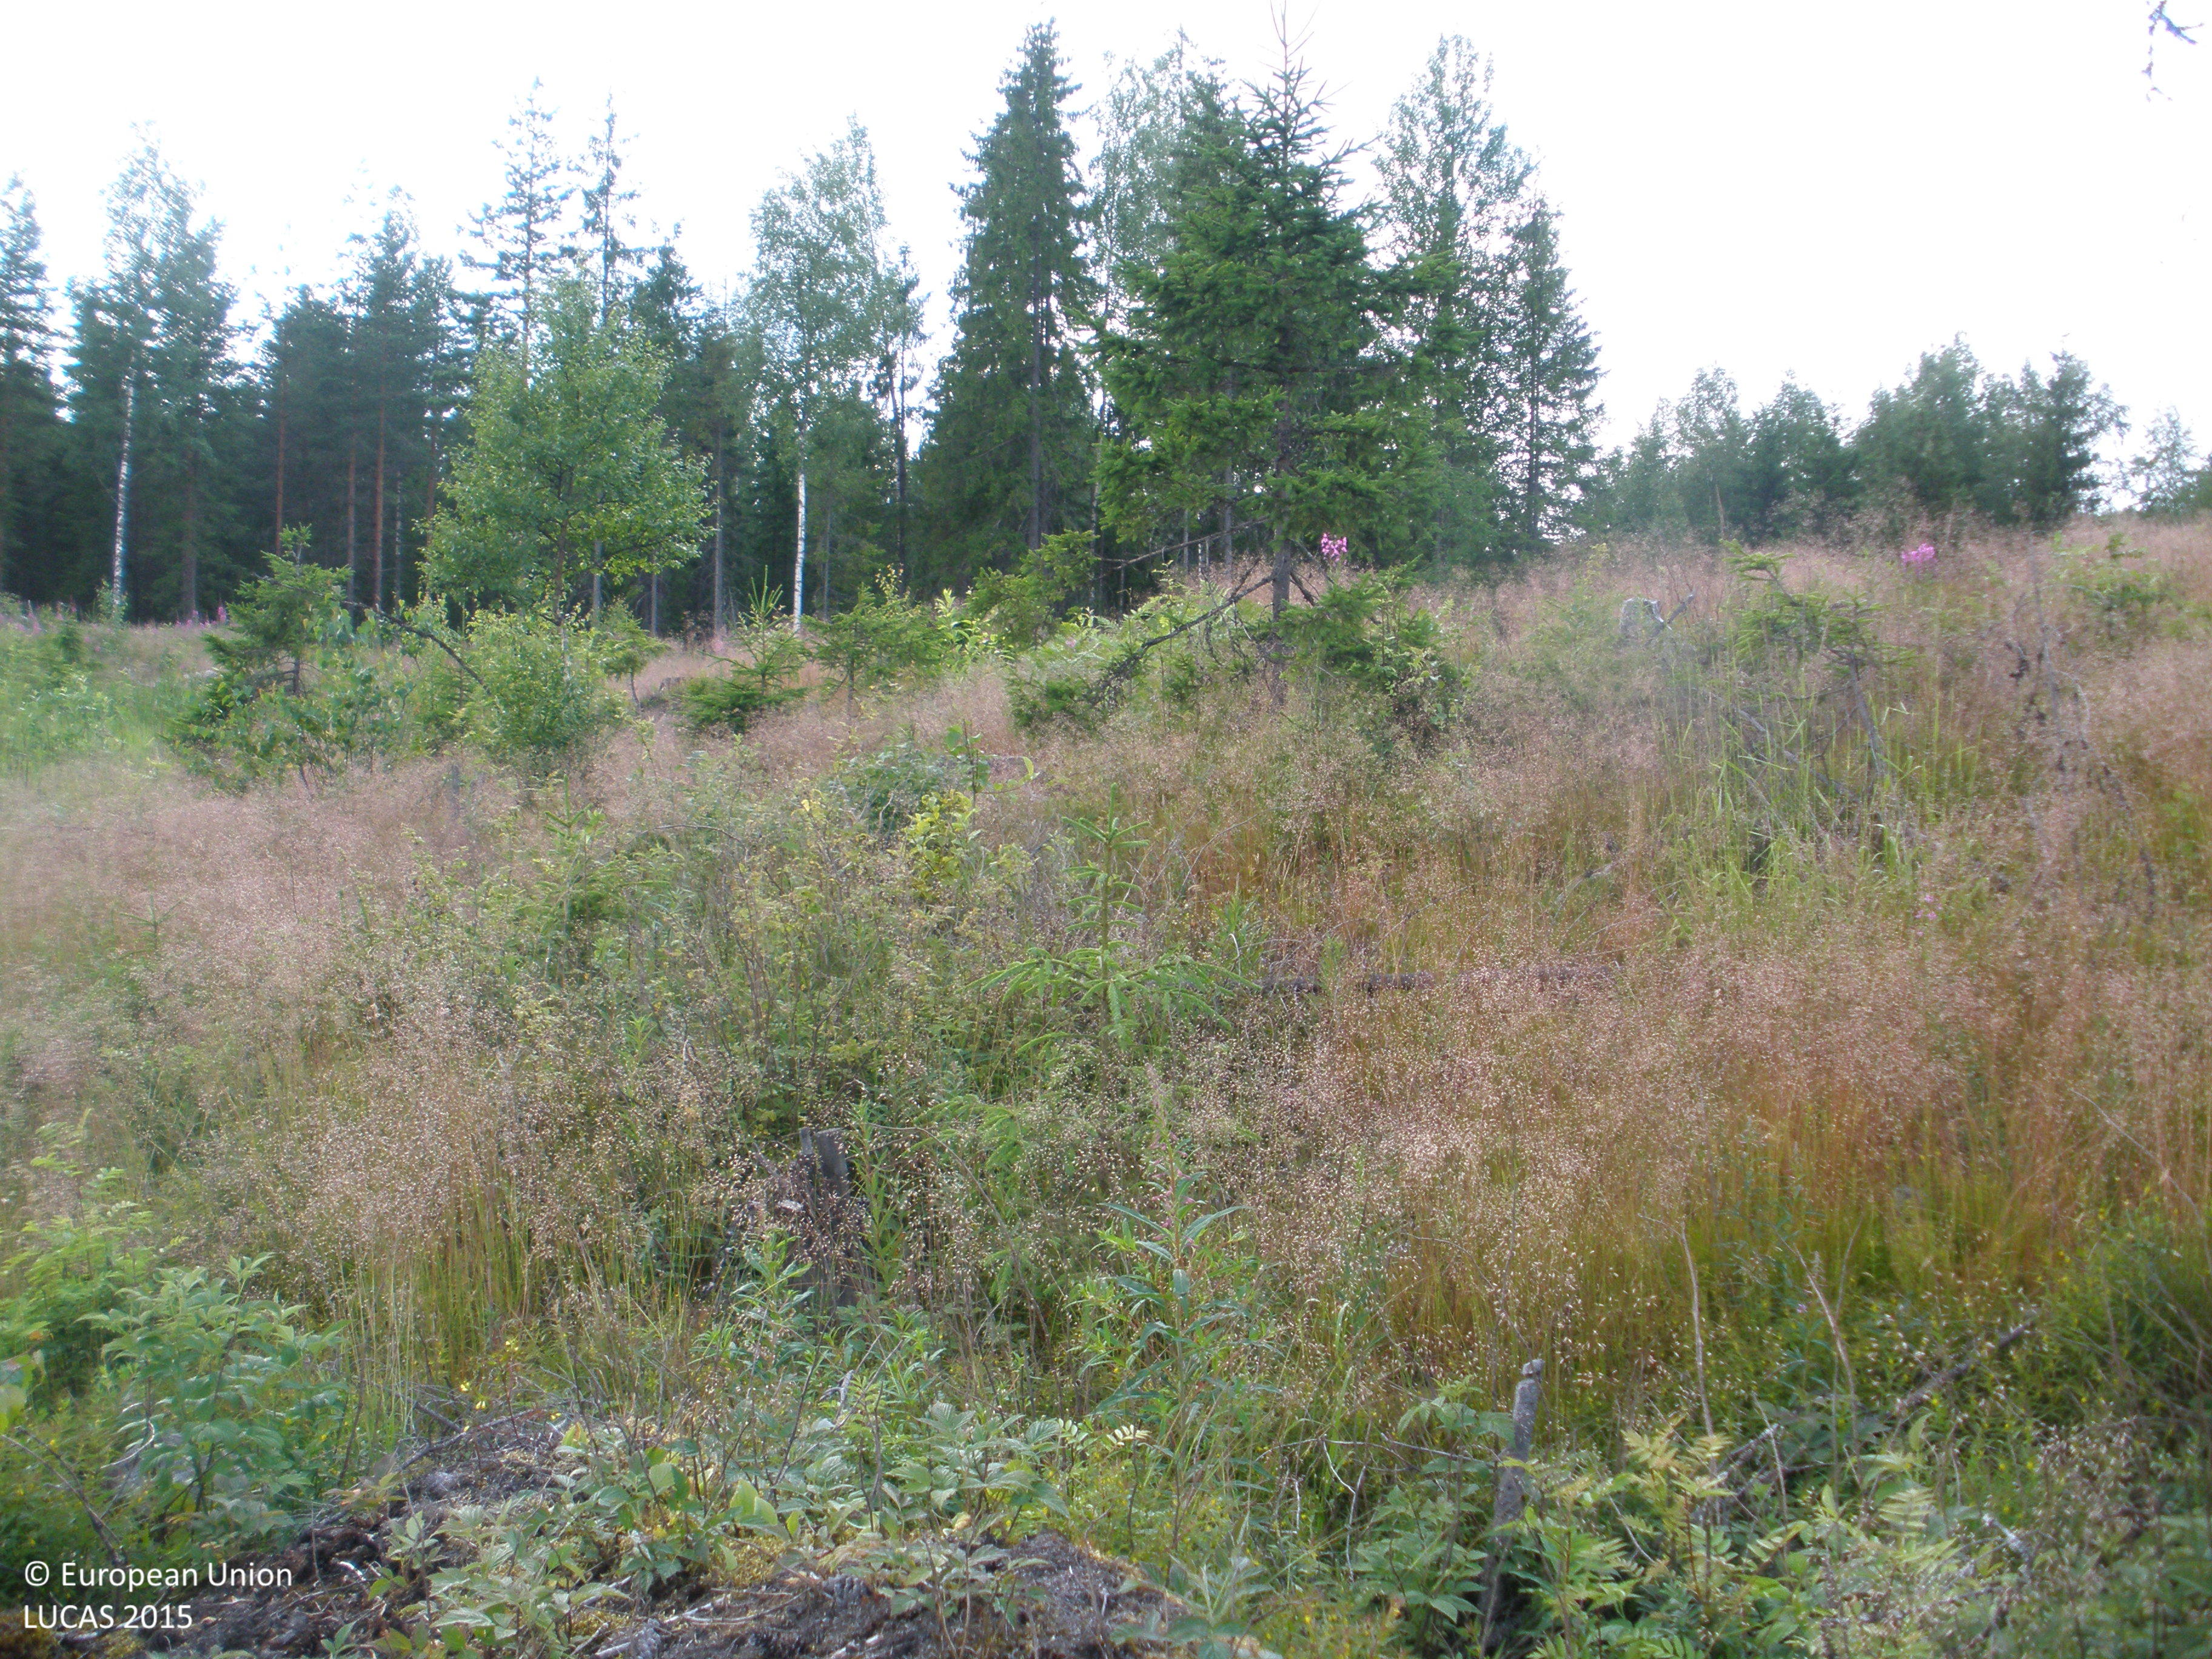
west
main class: Grassland
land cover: Grassland with sparse tree/shrub cover
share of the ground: > 75 %
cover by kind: herbaceous plants 90 %, coniferous forest trees 5 %, shrubs 5 %
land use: Forestry
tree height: < 5 m
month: July
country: FI
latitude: 61.3886
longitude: 23.9601
